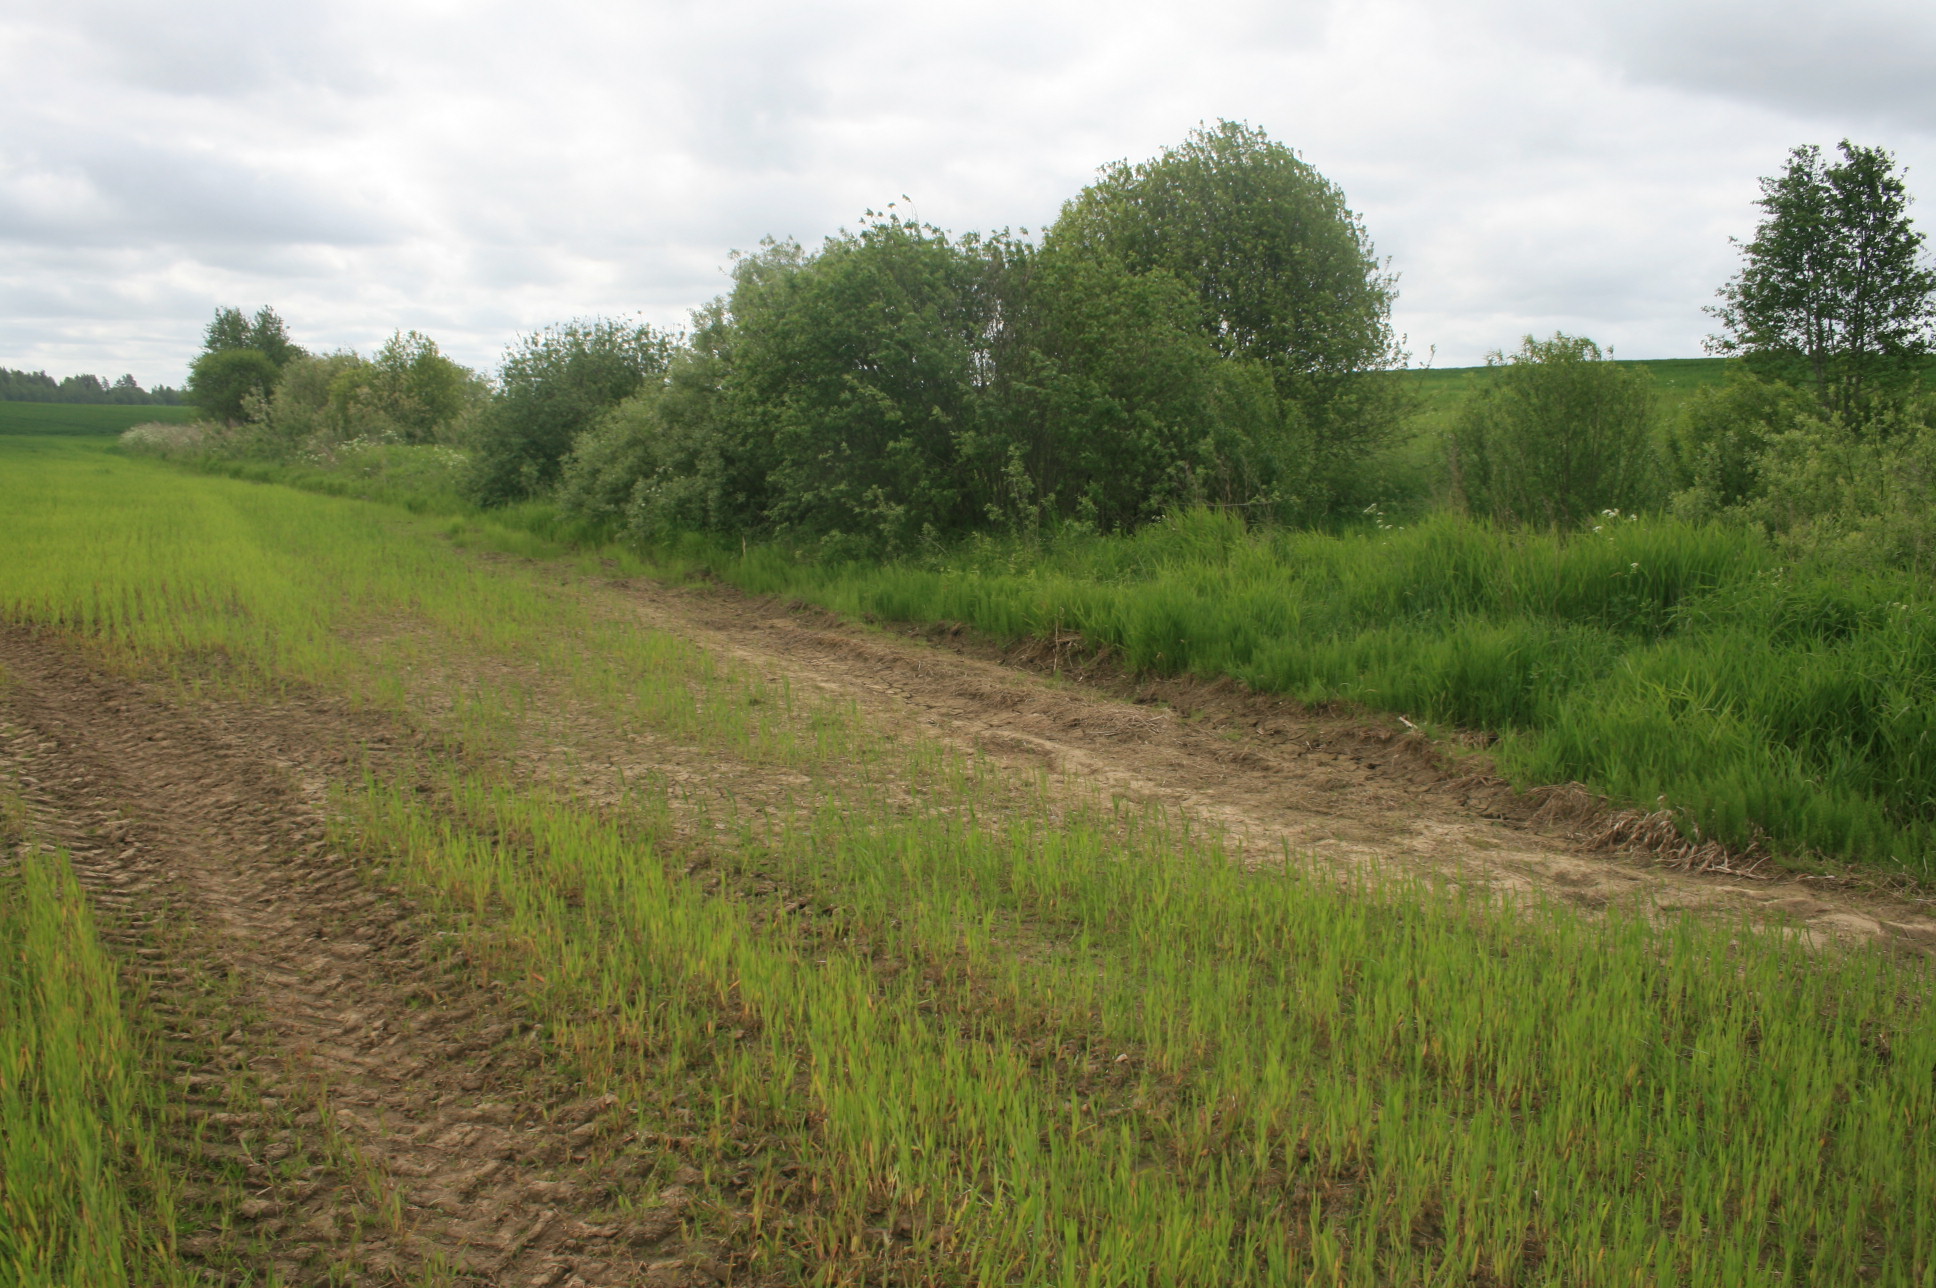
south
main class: Cropland
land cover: Rye
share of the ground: 50 - 75 %
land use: Agriculture (excluding fallow land and kitchen gardens)
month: June
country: LT
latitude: 56.2600
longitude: 22.3736
